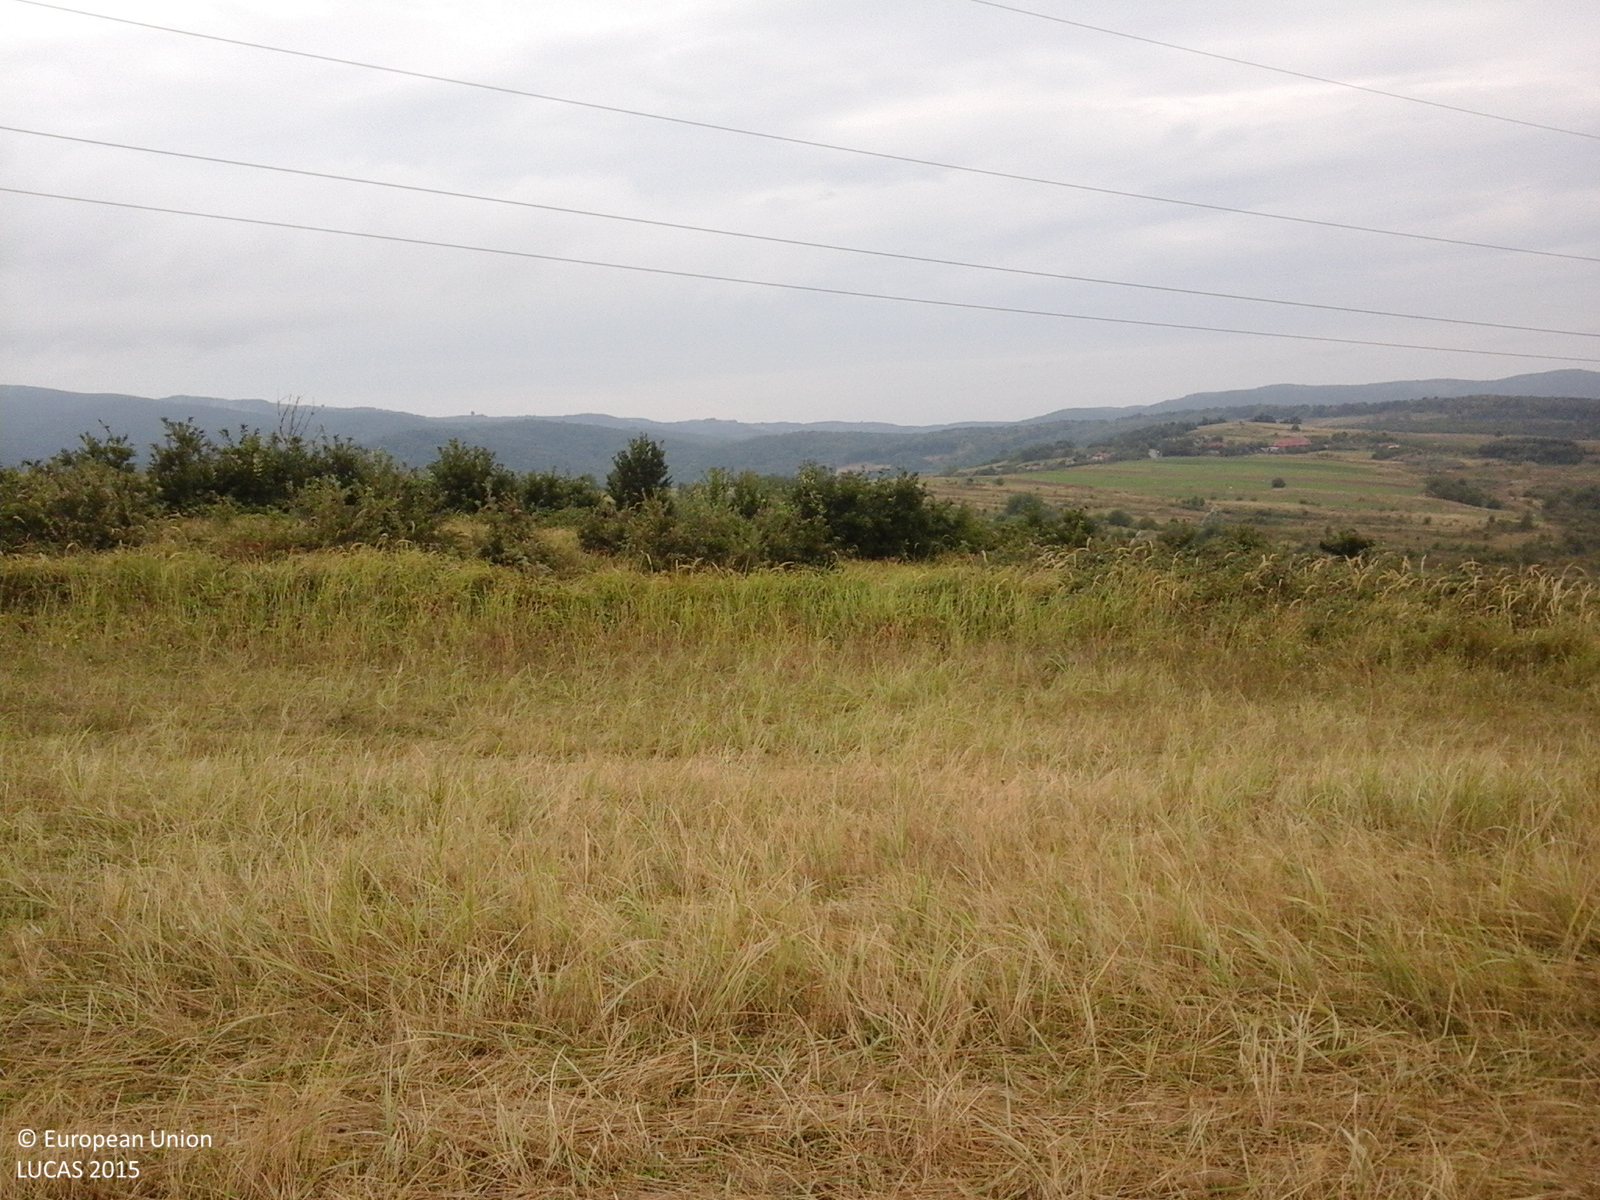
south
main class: Grassland
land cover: Grassland with sparse tree/shrub cover
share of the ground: > 75 %
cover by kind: herbaceous plants 85 %, shrubs 10 %, broadleaved forest trees 5 %
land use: Agriculture (excluding fallow land and kitchen gardens)
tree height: < 5 m
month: September
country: RO
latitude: 47.2169
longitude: 22.3466
